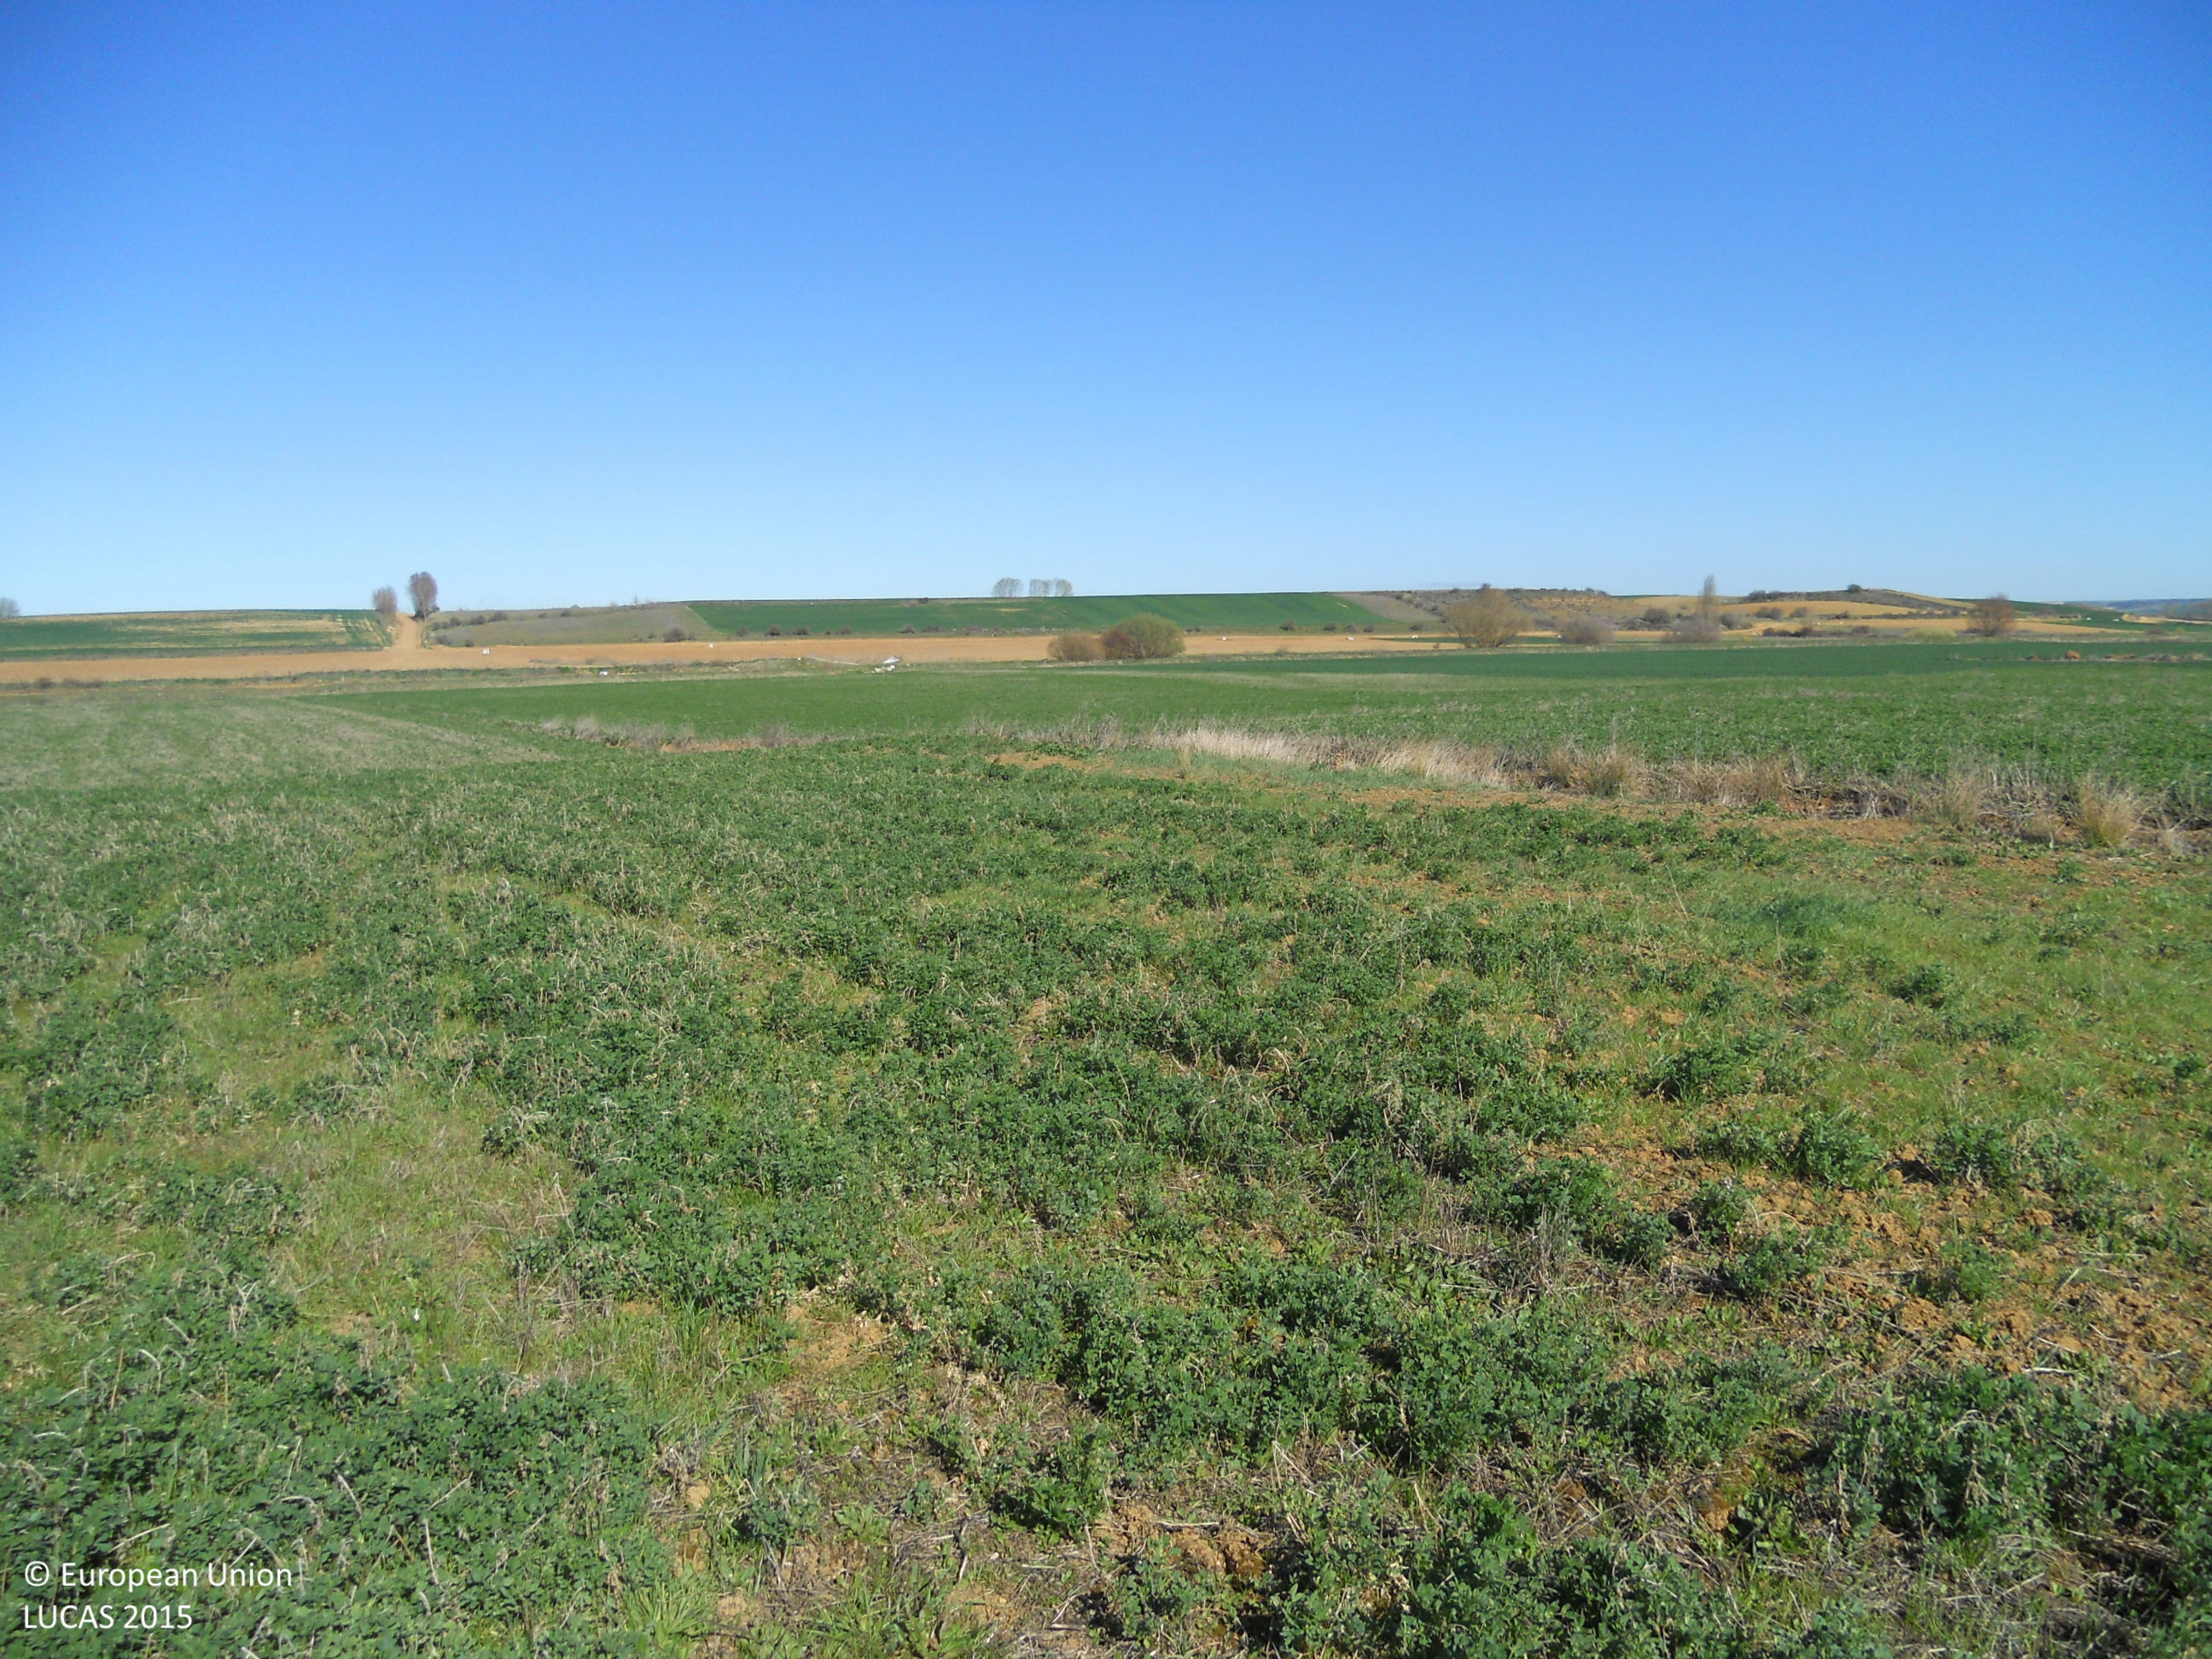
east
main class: Cropland
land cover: Lucerne
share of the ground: 50 - 75 %
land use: Agriculture (excluding fallow land and kitchen gardens)
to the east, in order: Lucerne; Grass margins; Ditches and canals; Grass margins; Lucerne; Grass margins; Barley; Grassland without tree/shrub cover; Rivers and streams; Grassland without tree/shrub cover; Other bare soil
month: April
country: ES
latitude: 42.3285
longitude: -4.3049
